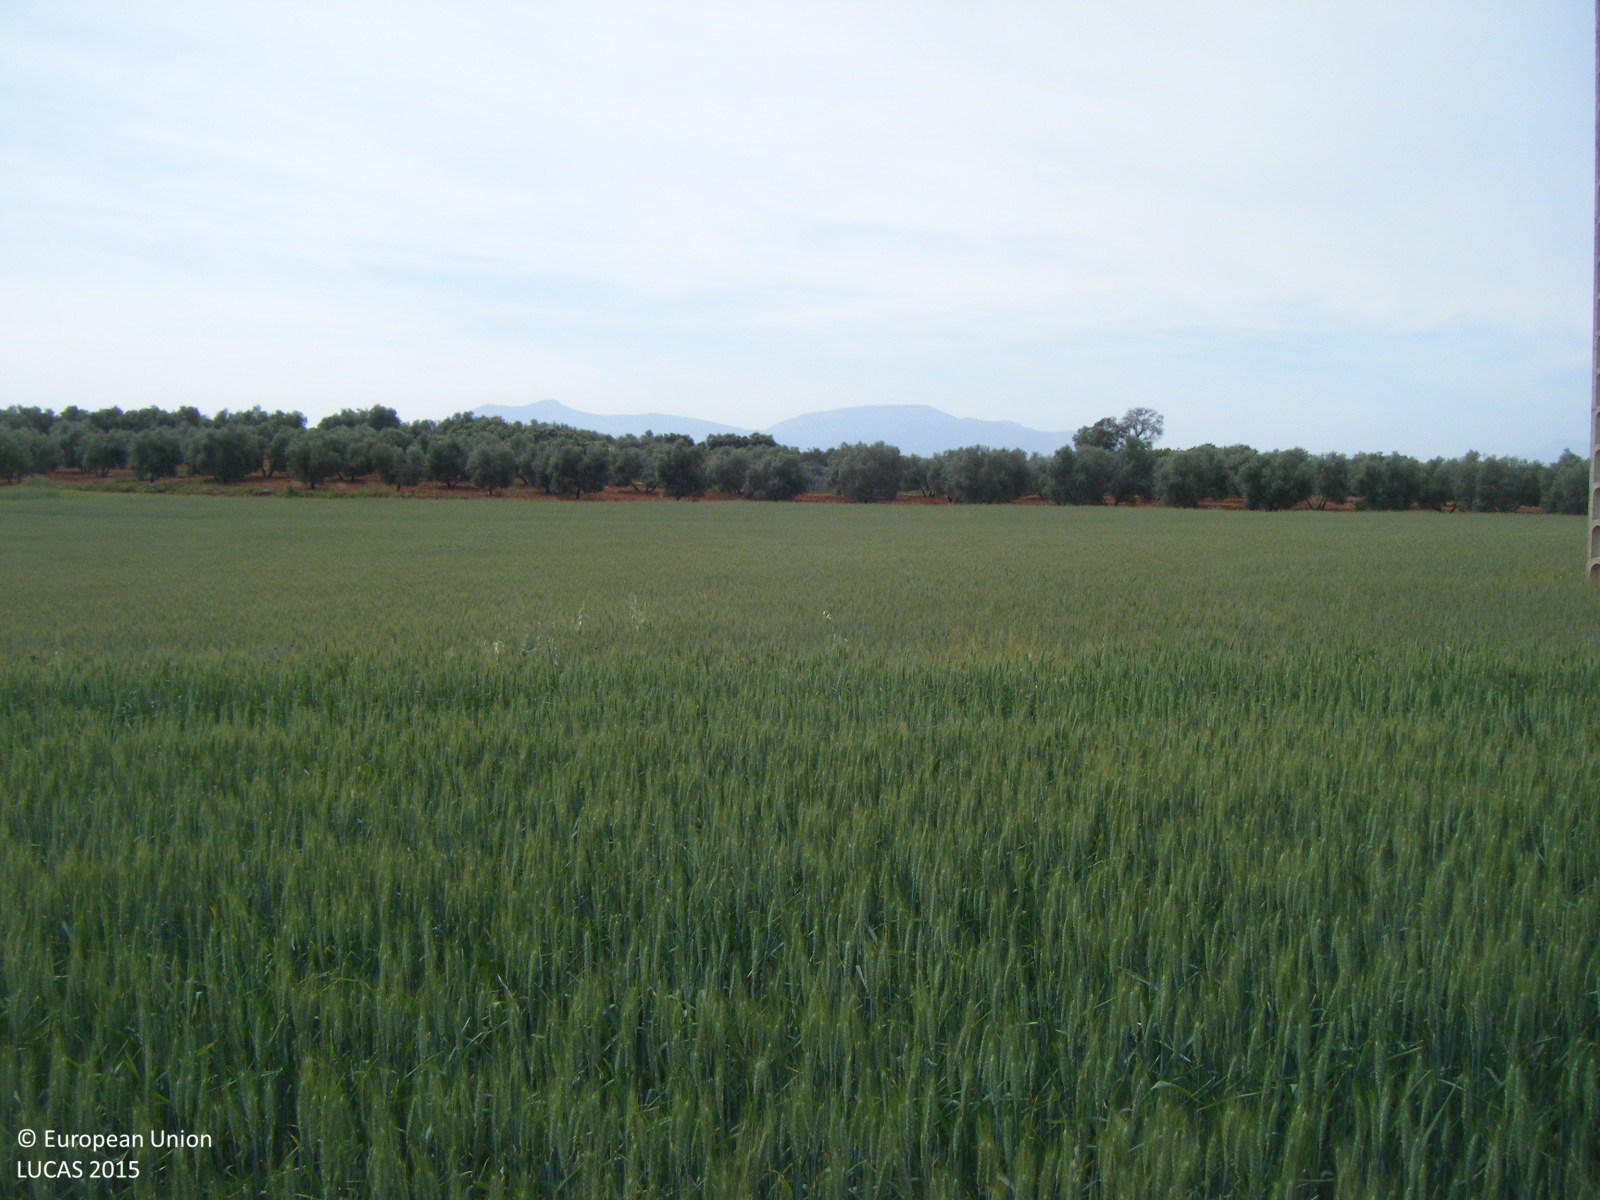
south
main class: Cropland
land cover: Durum wheat
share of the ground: > 75 %
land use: Agriculture (excluding fallow land and kitchen gardens)
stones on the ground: < 10 %
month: April
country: ES
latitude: 37.0840
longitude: -4.7709
